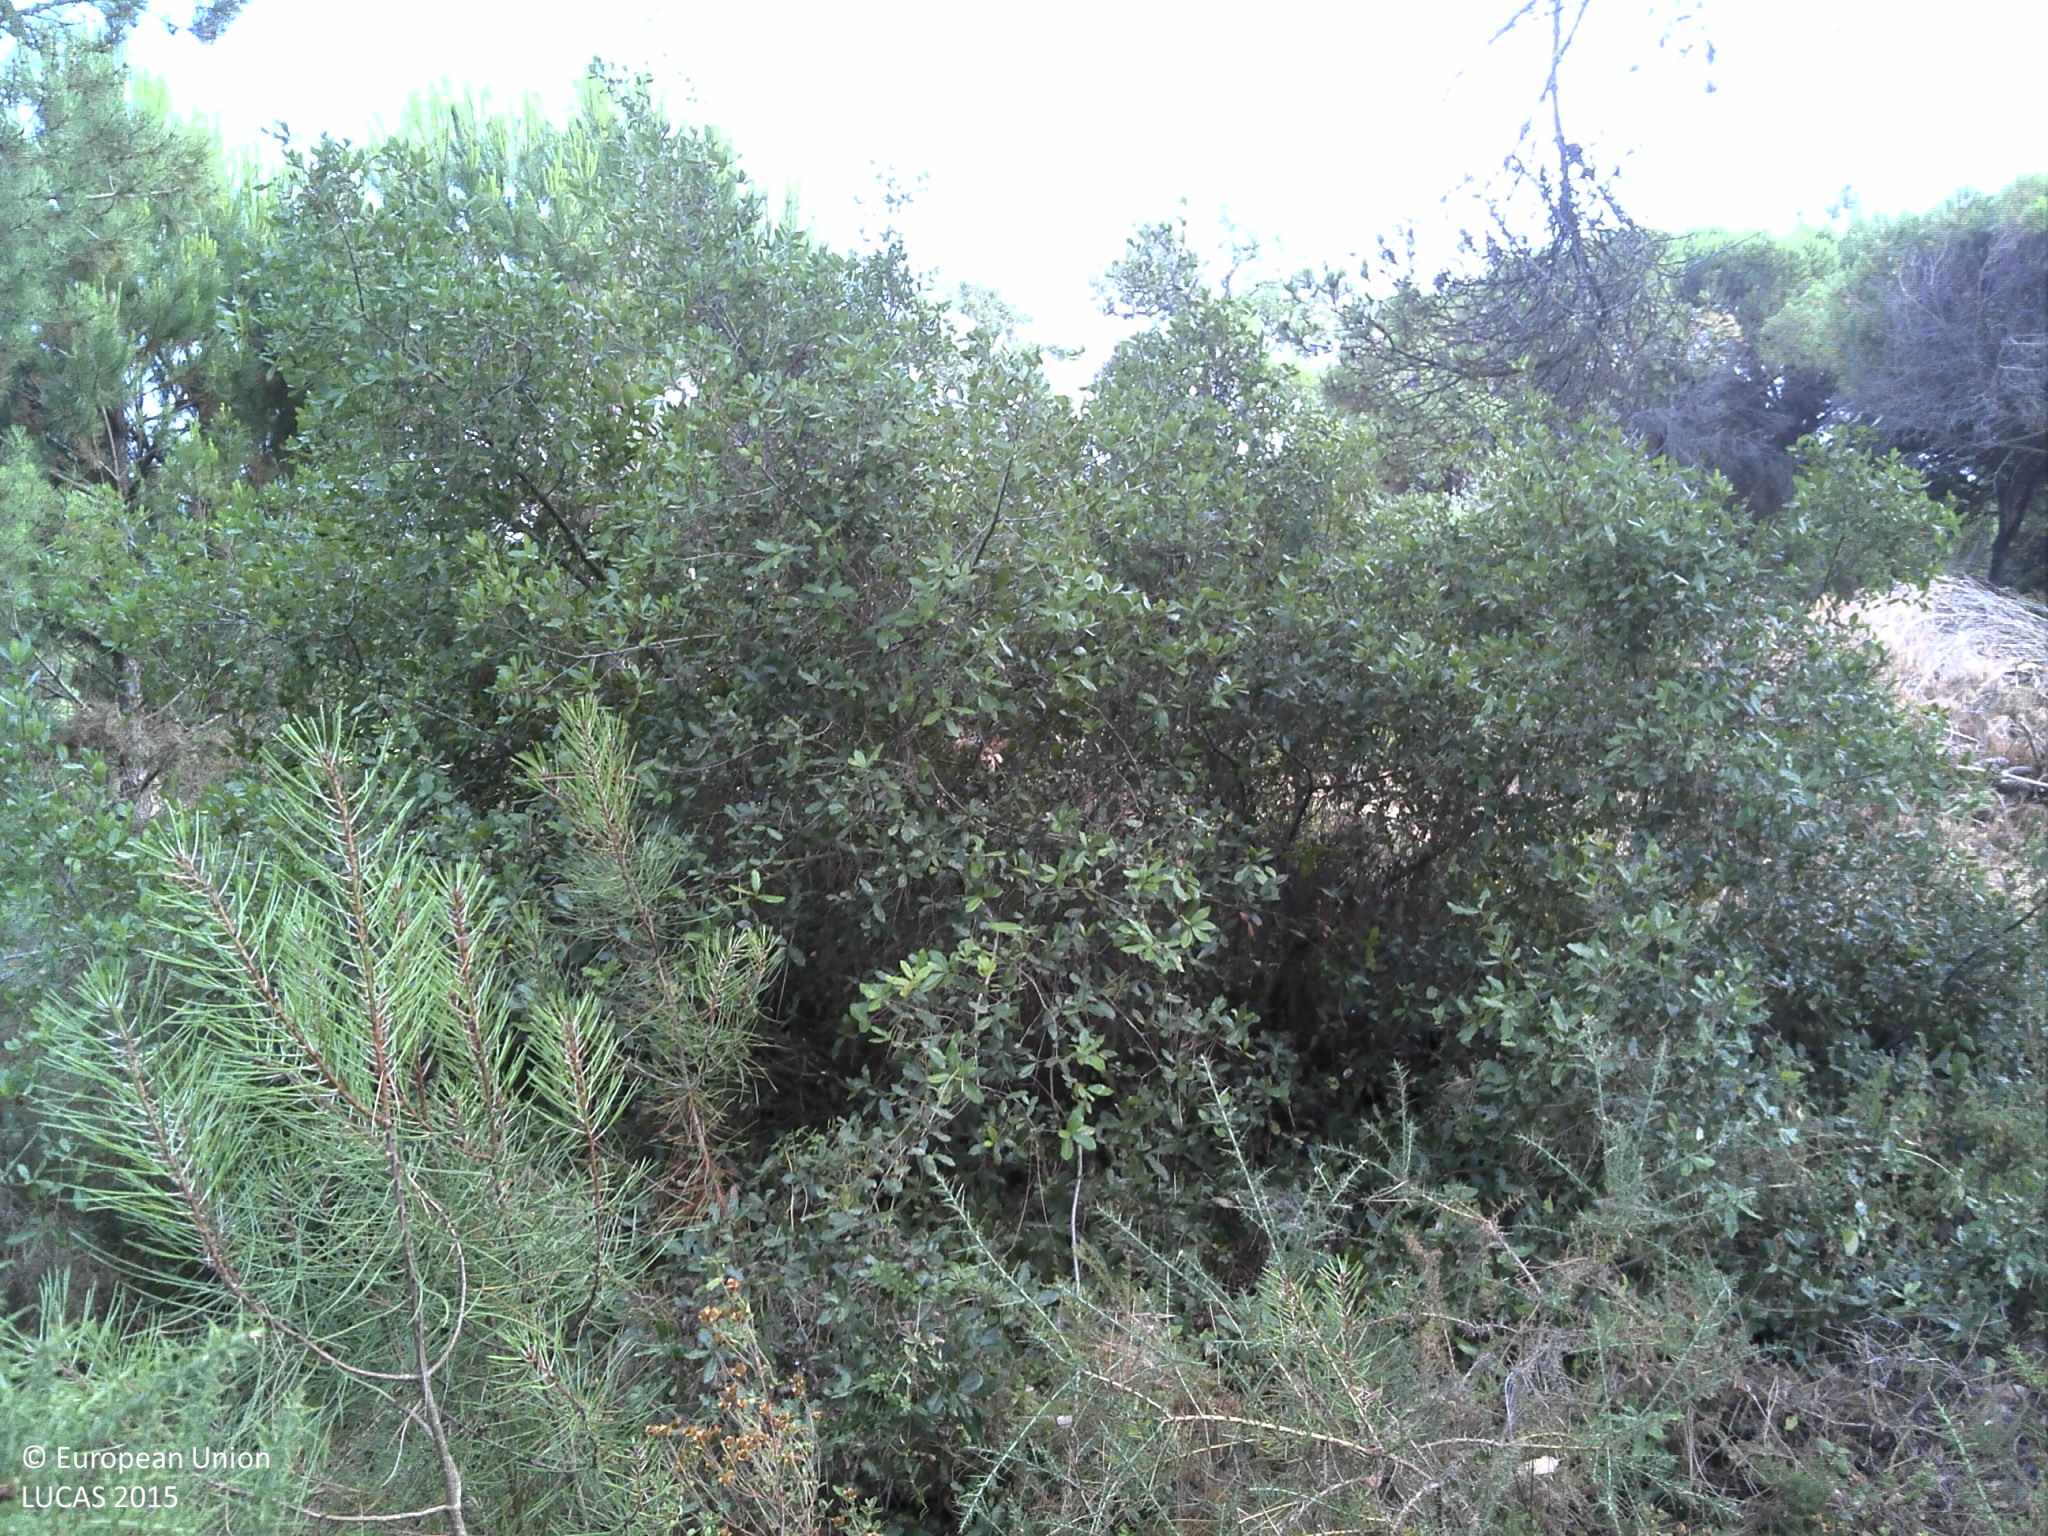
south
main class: Woodland
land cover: Pine dominated mixed woodland
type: coniferous forest of the mediterranean region
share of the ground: 50 - 75 %
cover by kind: coniferous forest trees 35 %, broadleaved forest trees 30 %, shrubs 20 %, unconsolidated bare surface 15 %
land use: Forestry
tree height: > 5 m
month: June
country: PT
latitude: 38.4802
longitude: -9.1098
